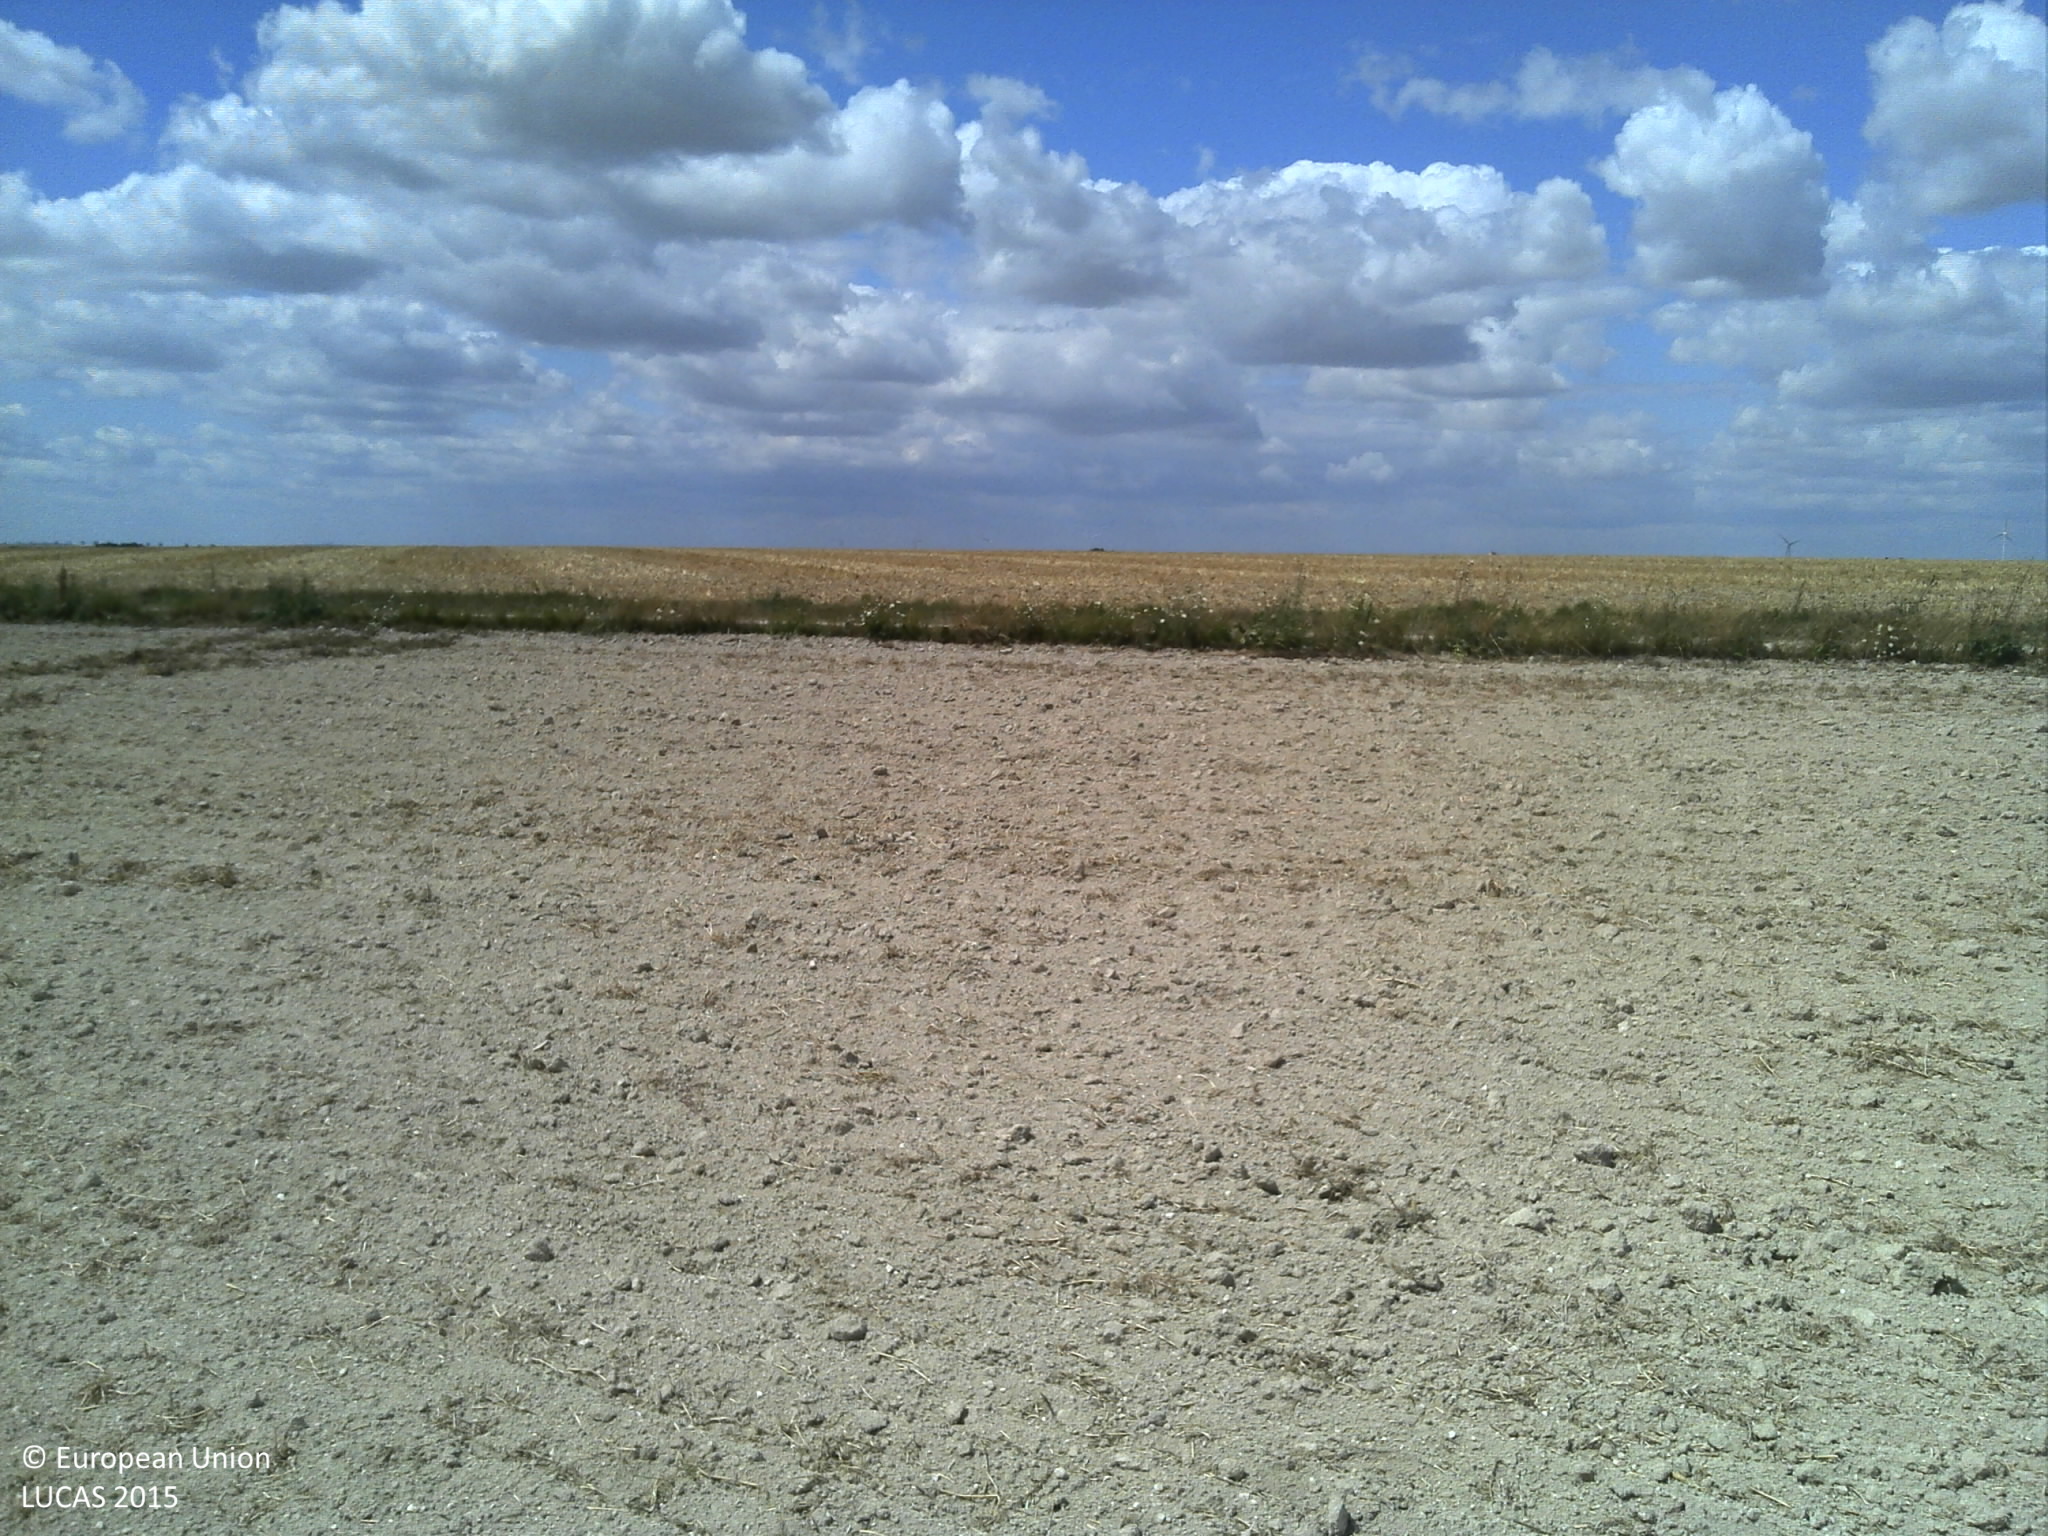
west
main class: Cropland
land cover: Dry pulses
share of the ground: < 10 %
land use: Agriculture (excluding fallow land and kitchen gardens)
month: July
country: FR
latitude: 49.3361
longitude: 4.6158
